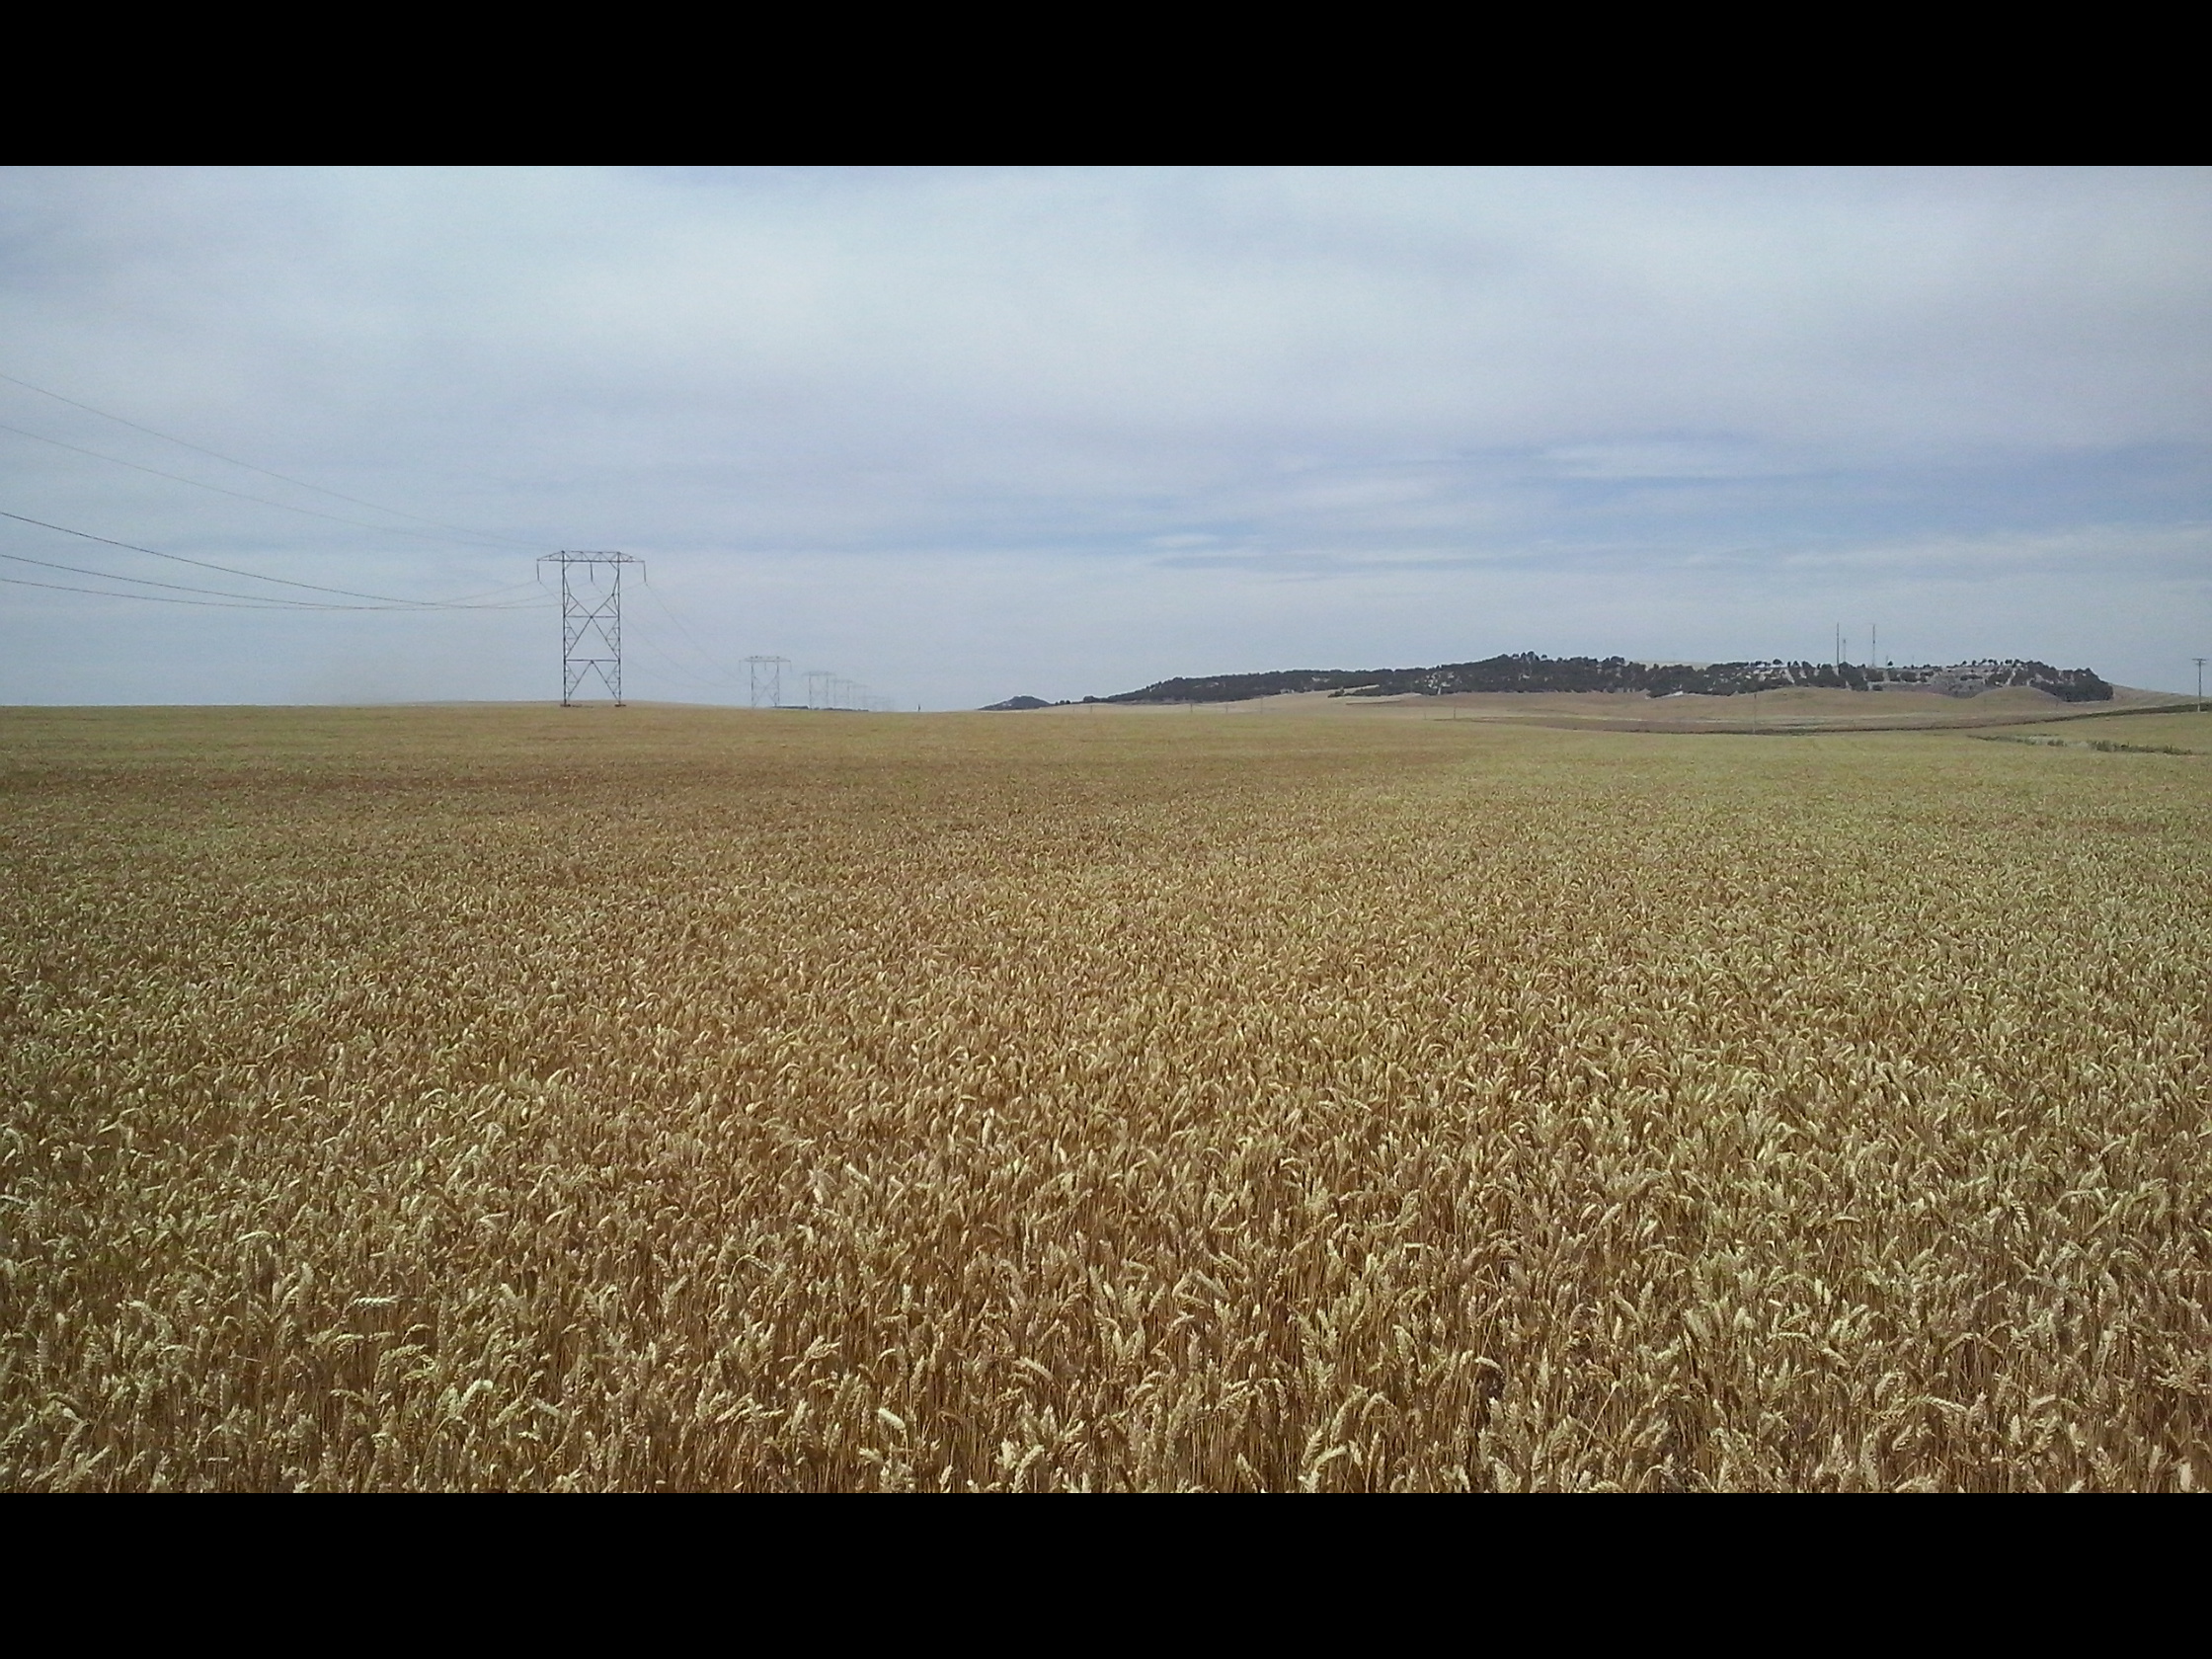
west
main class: Cropland
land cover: Common wheat
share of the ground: > 75 %
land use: Agriculture (excluding fallow land and kitchen gardens)
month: July
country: ES
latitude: 41.6011
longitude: -5.1335
